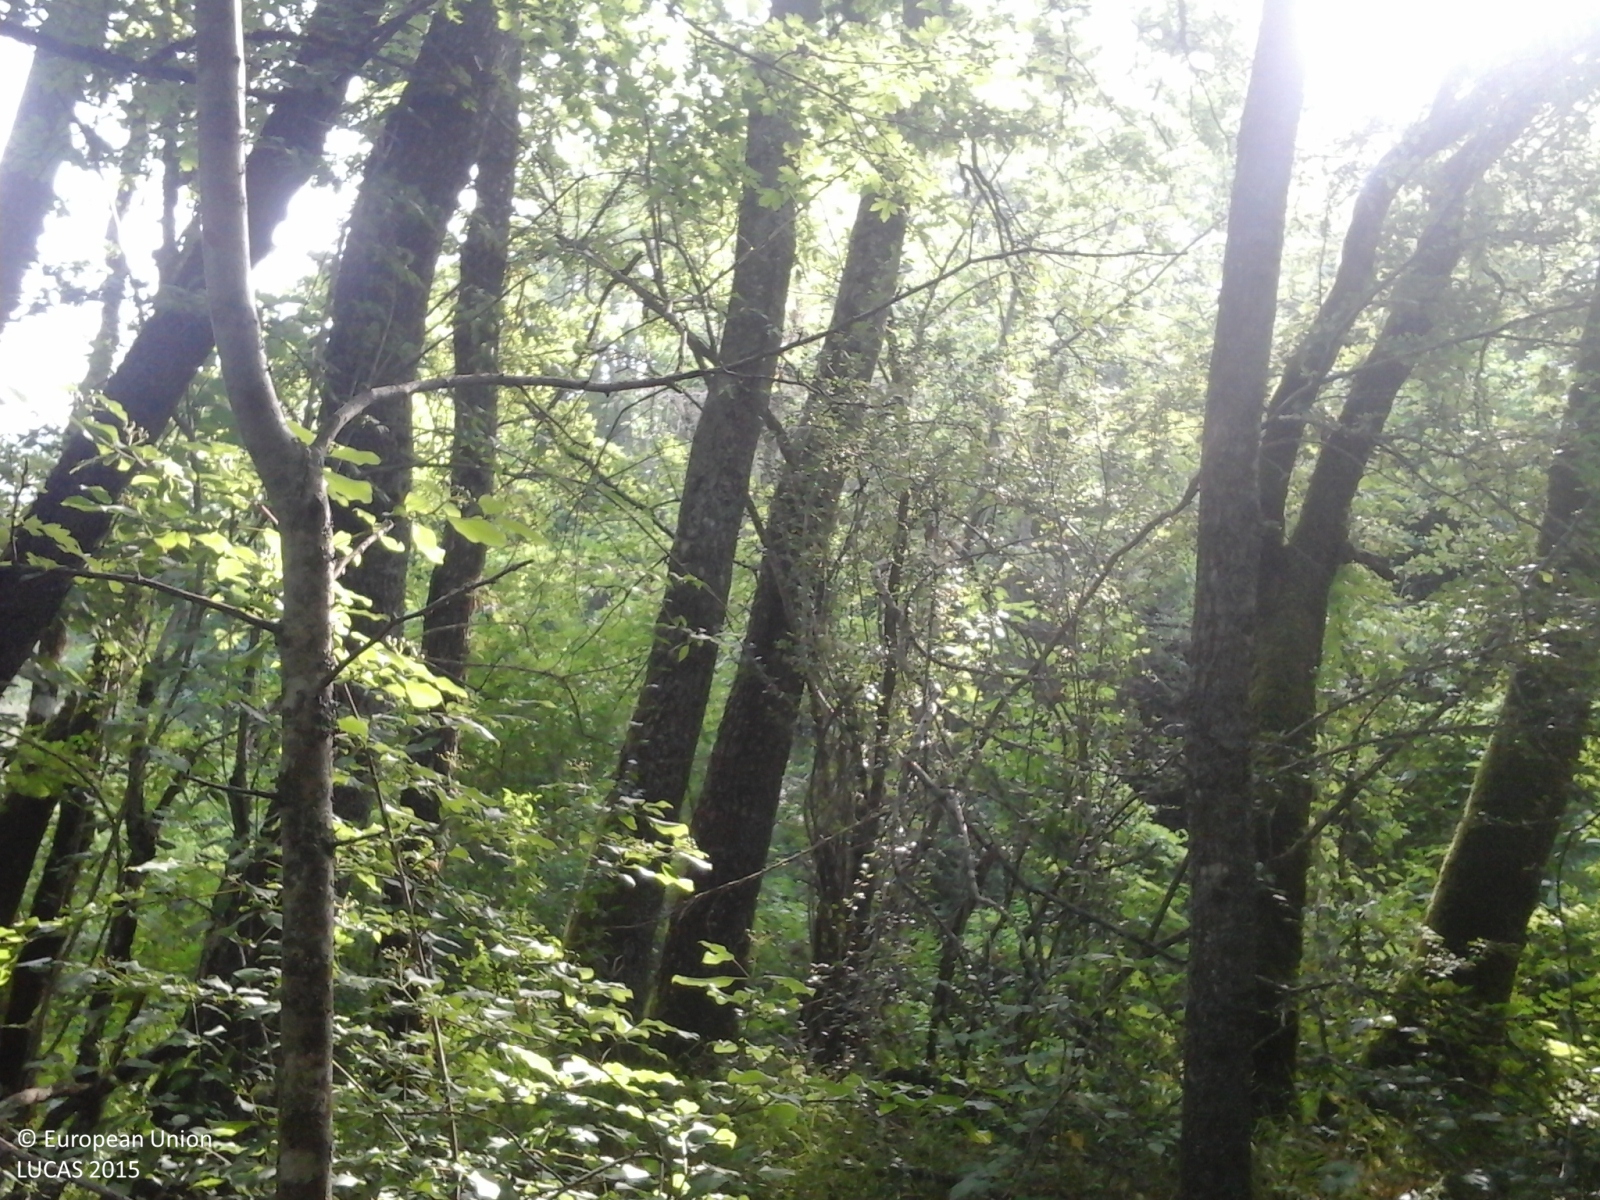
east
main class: Woodland
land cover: Broadleaved woodland
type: thermophilous deciduous forest
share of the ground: > 75 %
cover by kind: broadleaved forest trees 100 %
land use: Forestry
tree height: > 5 m
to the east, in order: Broadleaved woodland; Grassland without tree/shrub cover; Broadleaved woodland; Grassland without tree/shrub cover; Managed hedges; Lucerne; Managed hedges
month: July
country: IT
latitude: 44.4406
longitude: 10.1880
